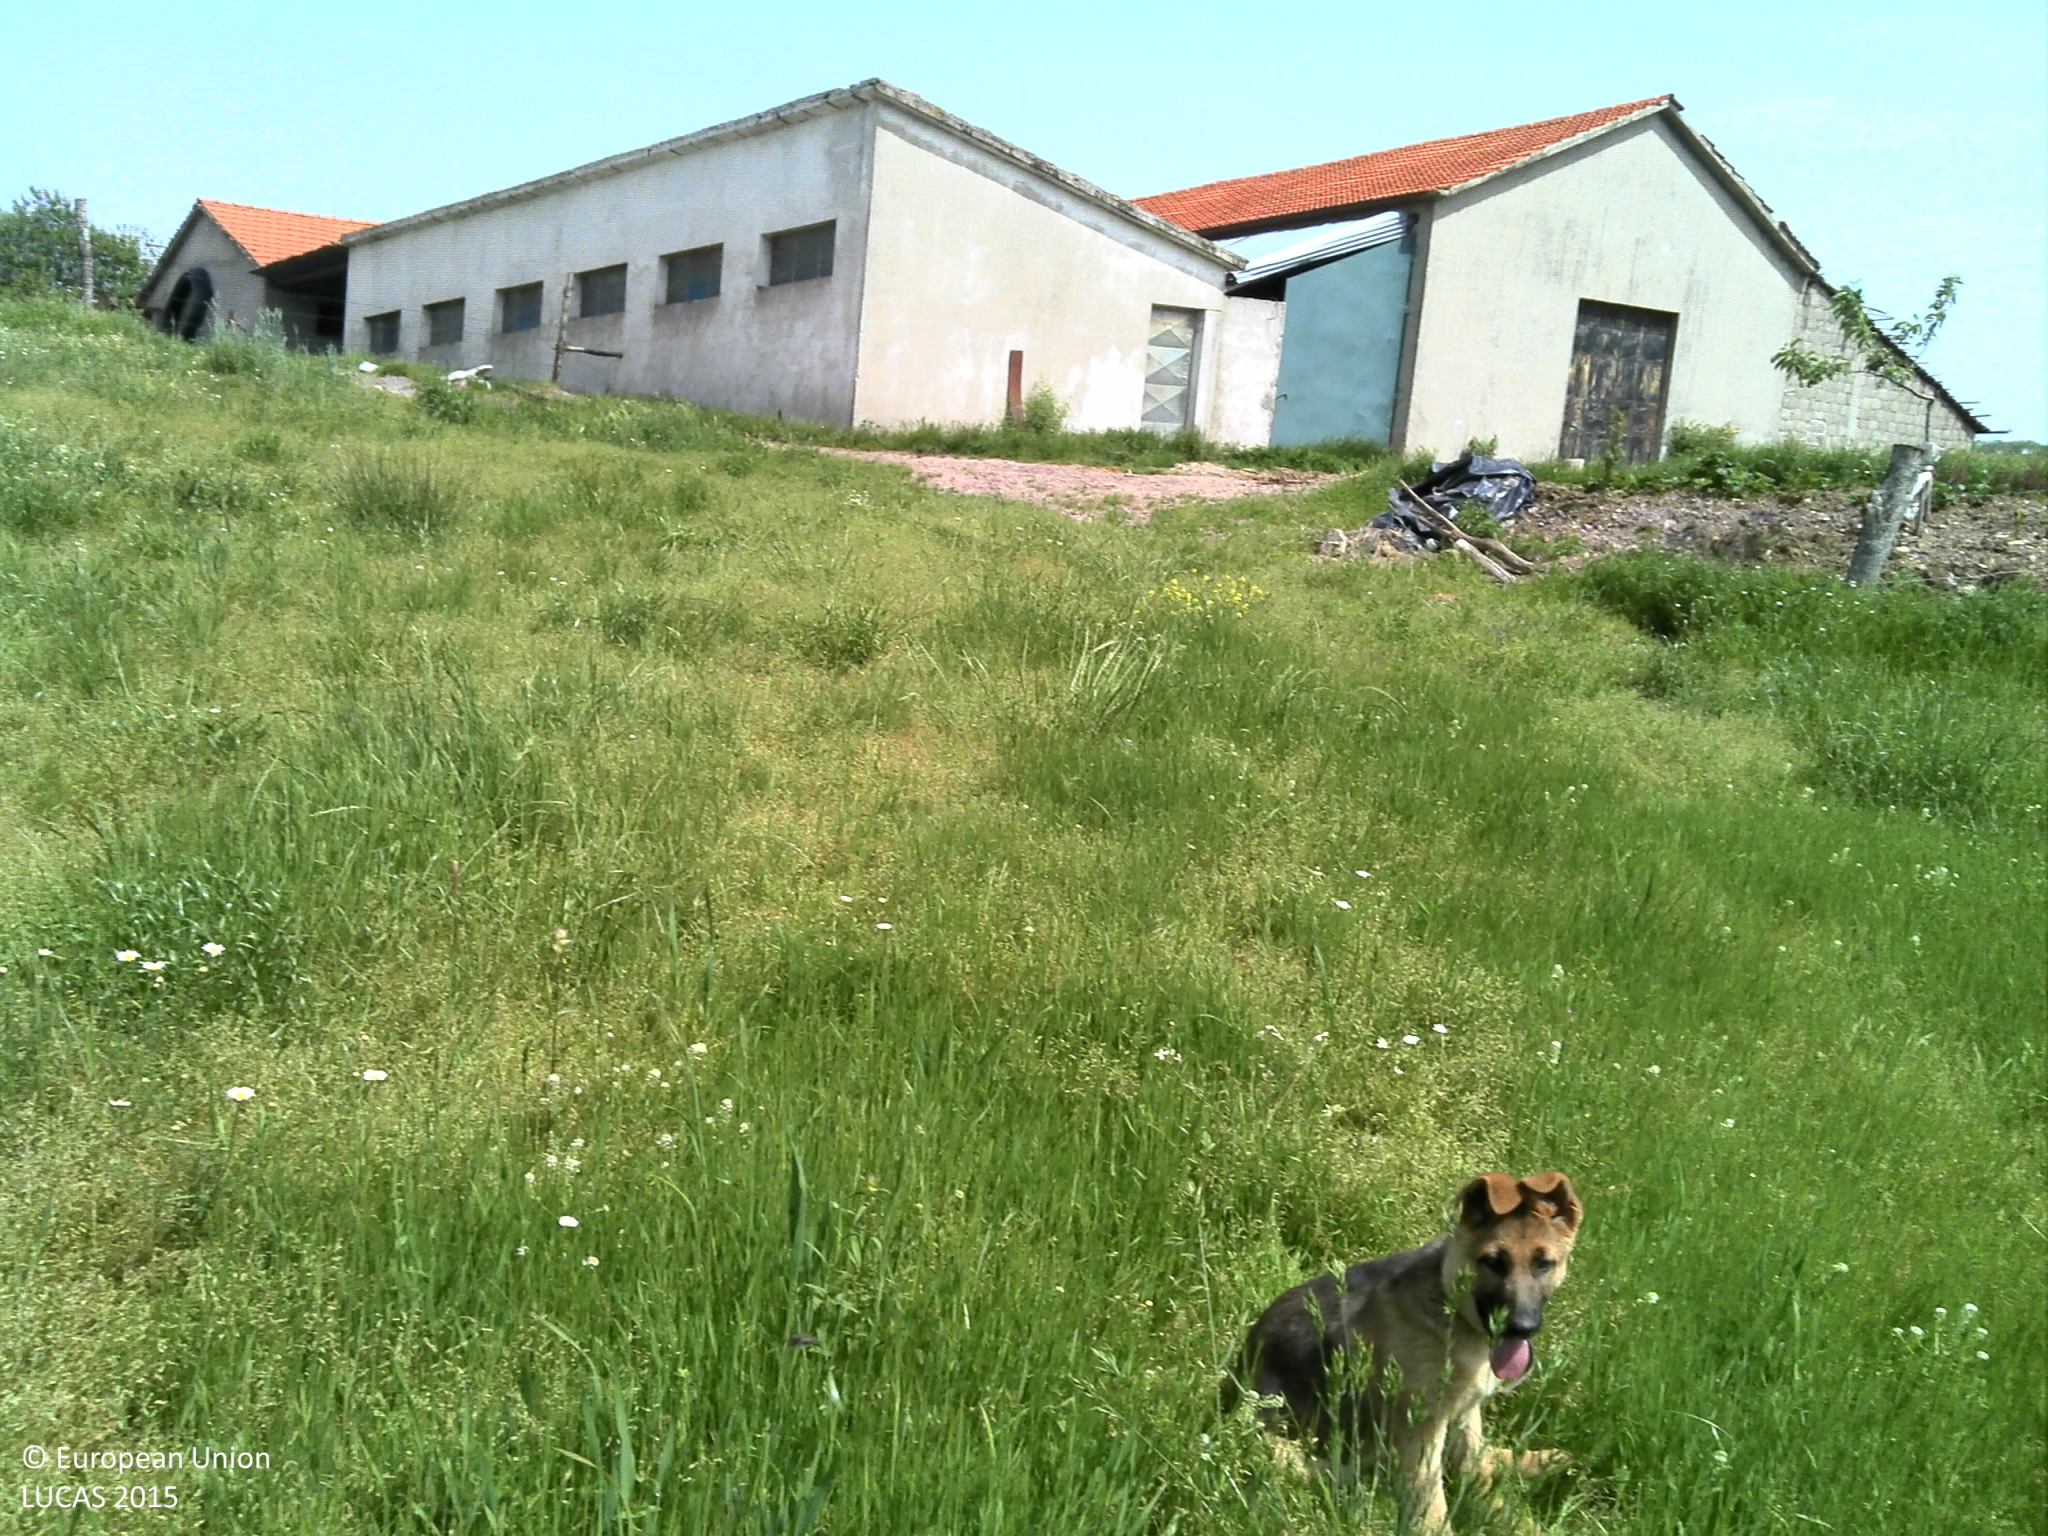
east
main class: Grassland
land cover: Spontaneously vegetated surfaces
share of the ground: > 75 %
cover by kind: herbaceous plants 95 %, unconsolidated bare surface 5 %
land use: Agriculture (excluding fallow land and kitchen gardens)
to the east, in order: Spontaneously vegetated surfaces; Fences; Tracks; Grass margins; Artificial constructions in urban areas; Tracks; Grass margins; Abandoned hedges; Spontaneously vegetated surfaces; Abandoned hedges; Dry stone walls; Tracks; Dry stone walls; Grassland without tree/shrub cover; Electric lines; Grassland without tree/shrub cover; Grassland with sparse tree/shrub cover
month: May
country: PT
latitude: 41.7623
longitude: -6.9691
